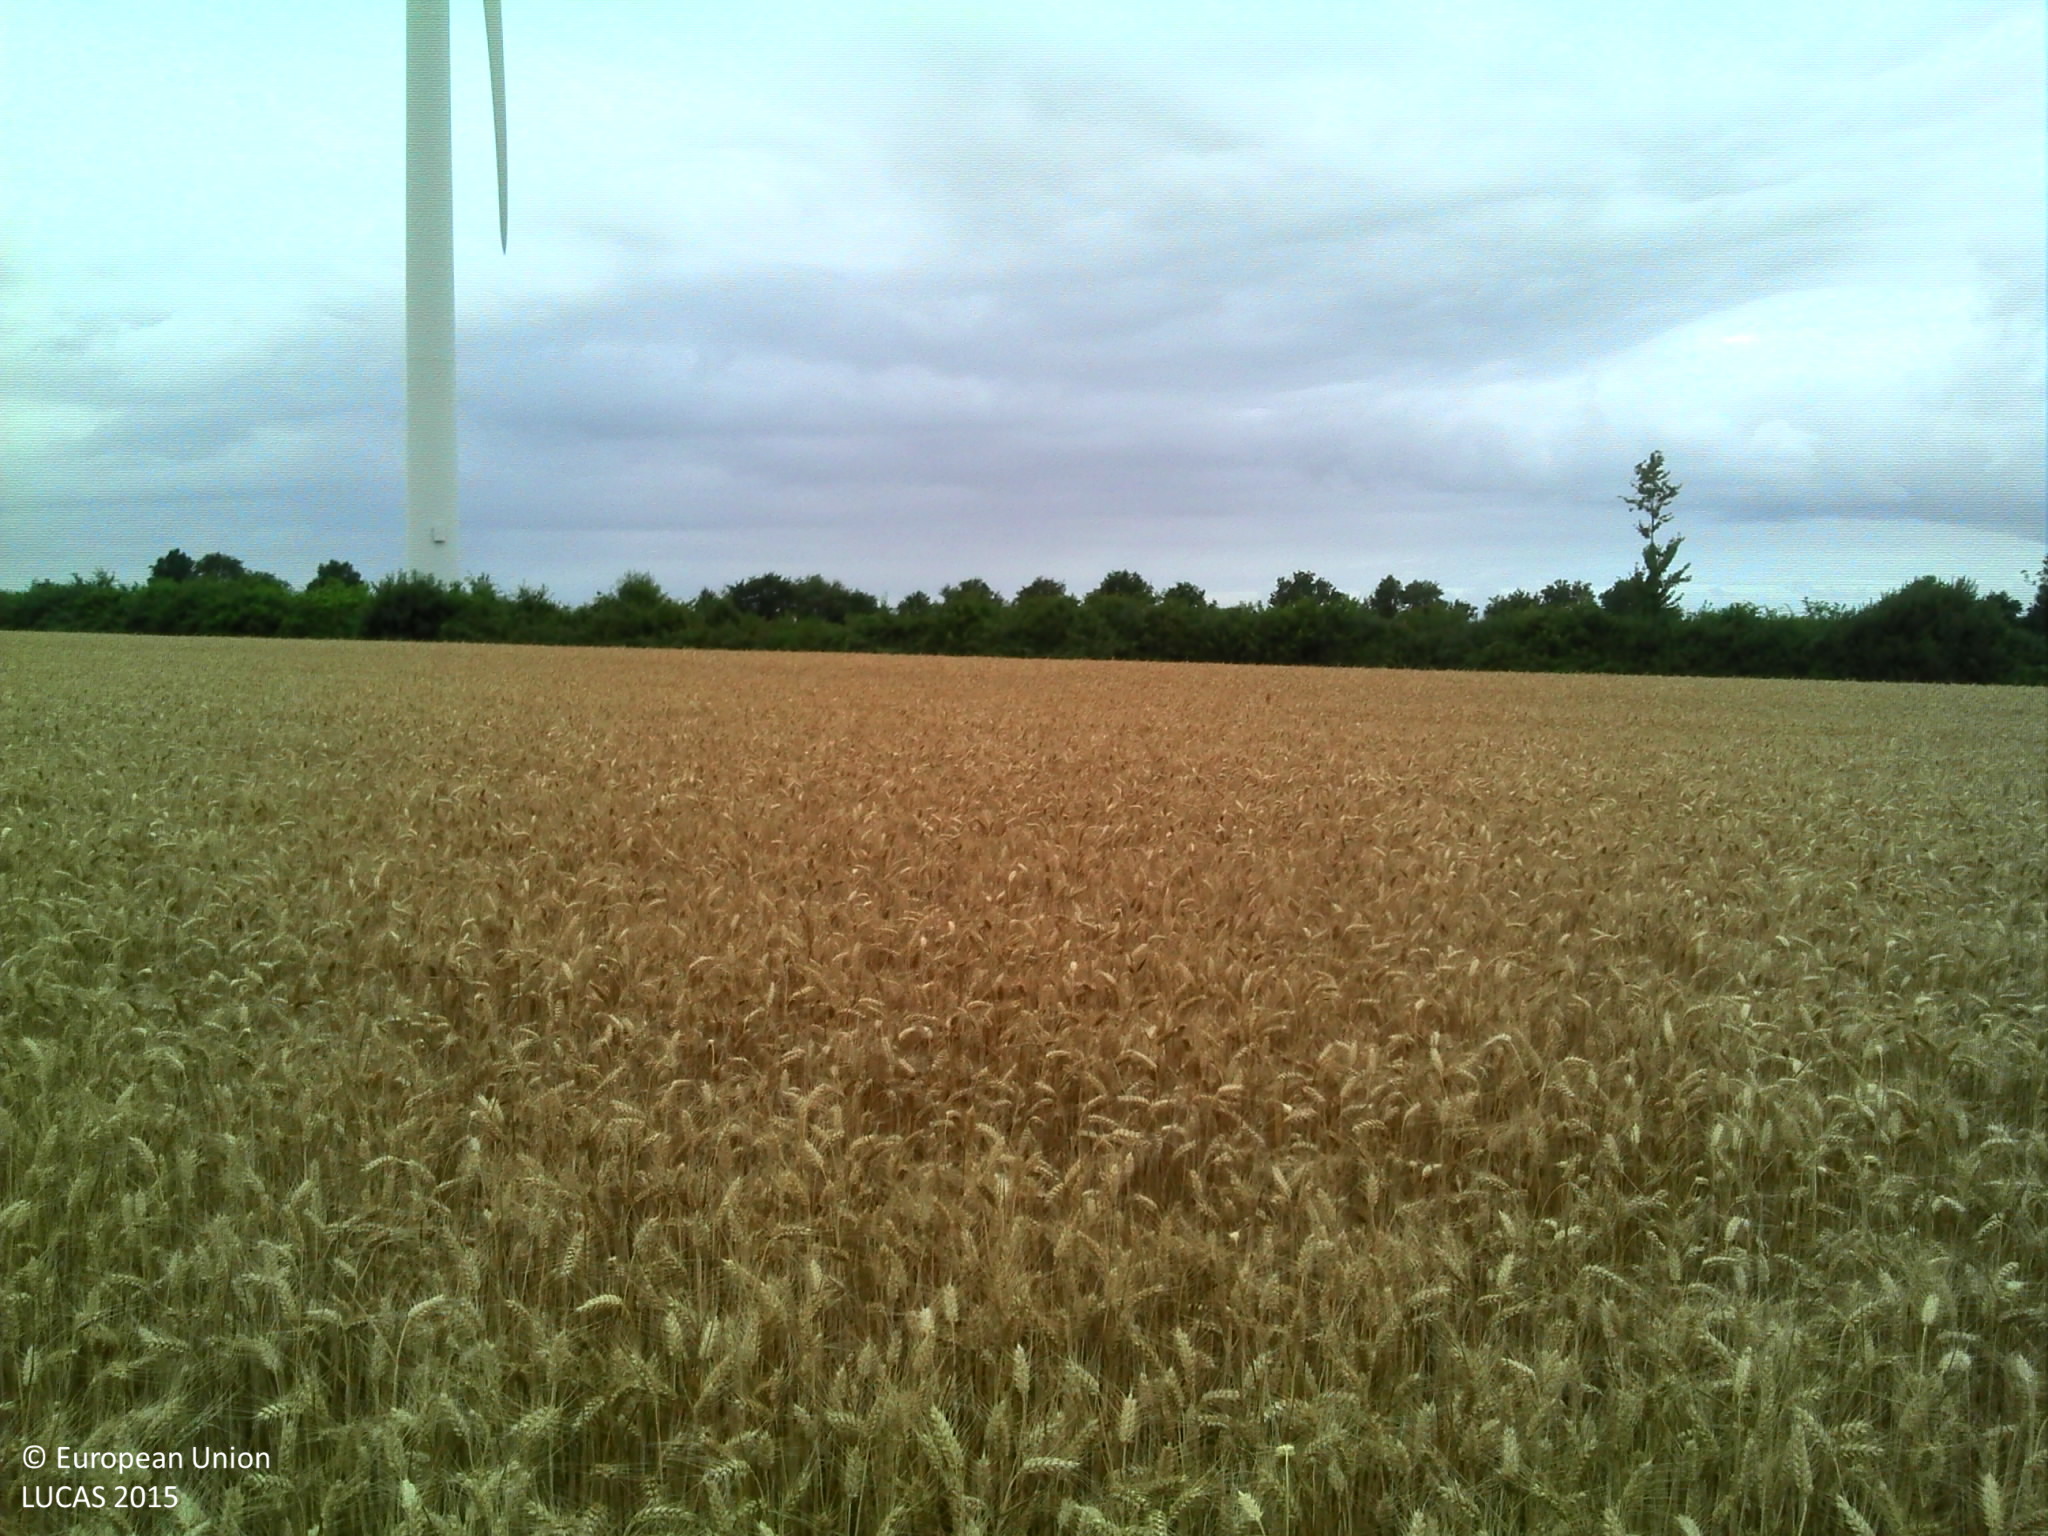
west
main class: Cropland
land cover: Common wheat
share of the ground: > 75 %
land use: Agriculture (excluding fallow land and kitchen gardens)
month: July
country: FR
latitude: 46.9973
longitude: -1.7075
